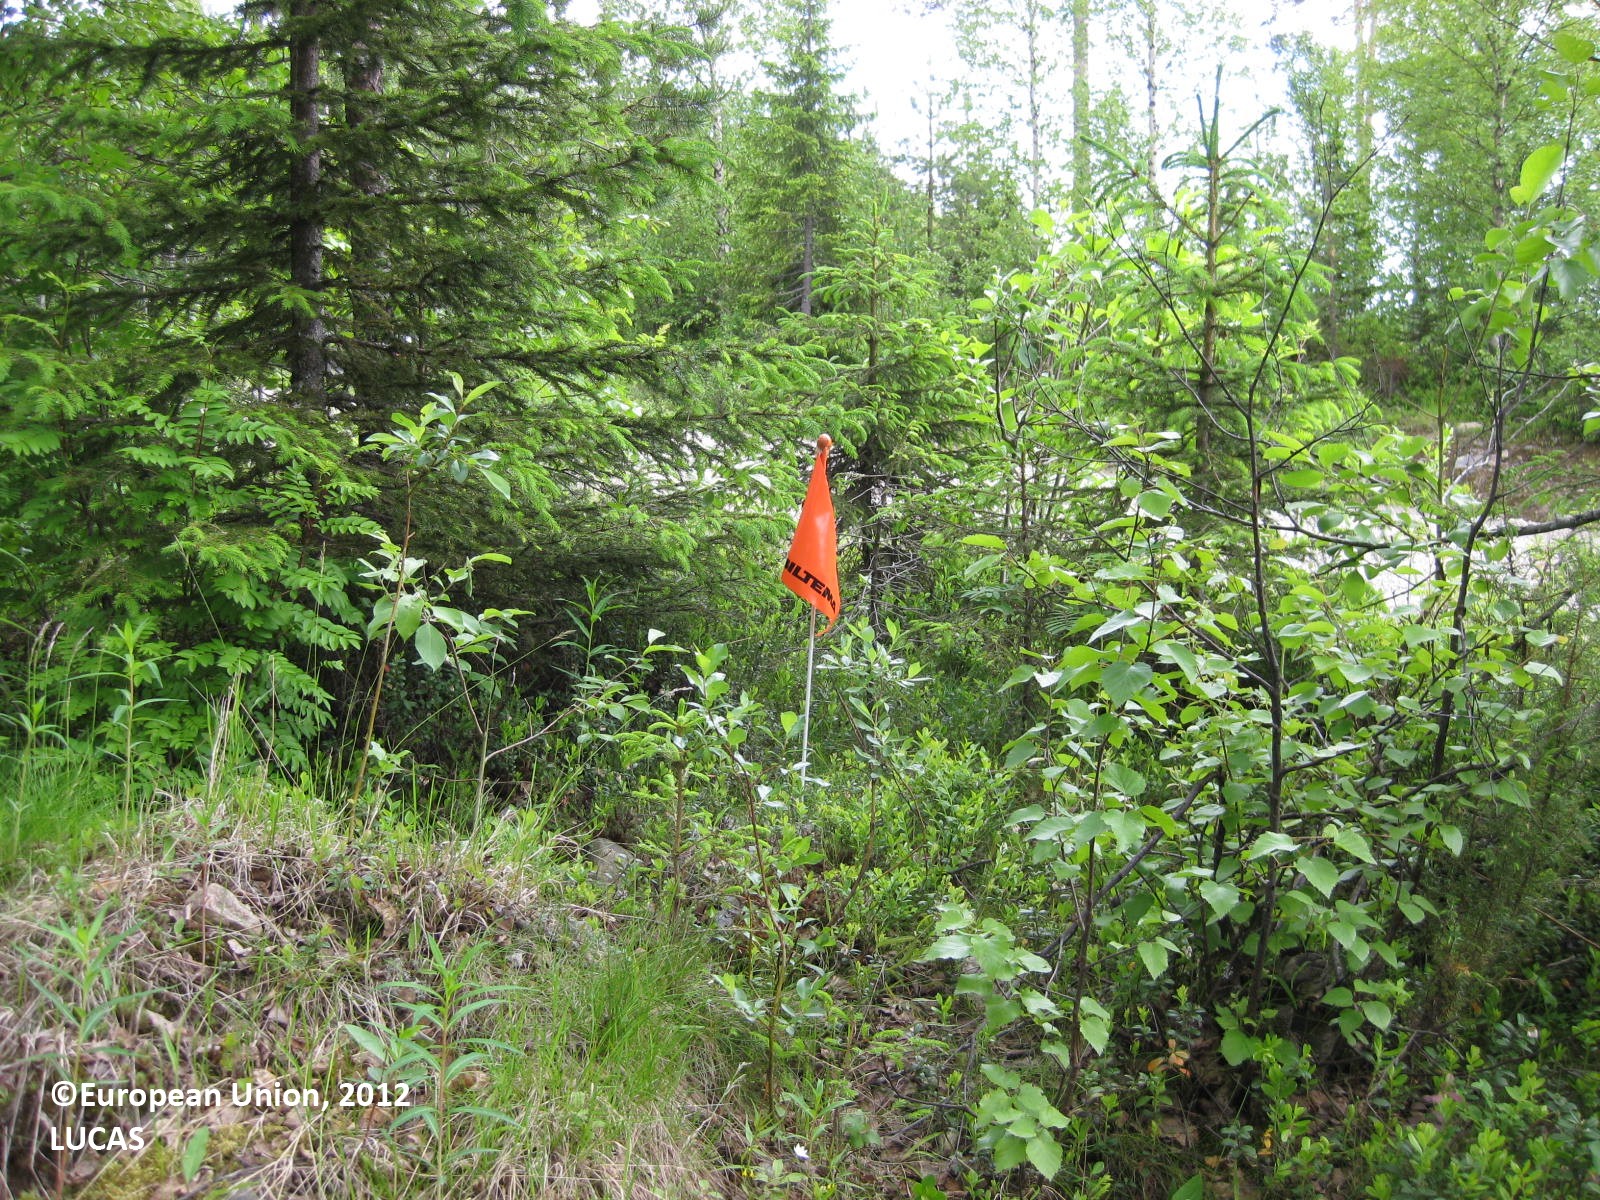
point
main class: Woodland
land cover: Spruce dominated mixed woodland
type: boreal forest
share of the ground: > 75 %
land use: Forestry
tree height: > 5 m
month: June
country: FI
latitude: 65.3003
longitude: 28.2803
